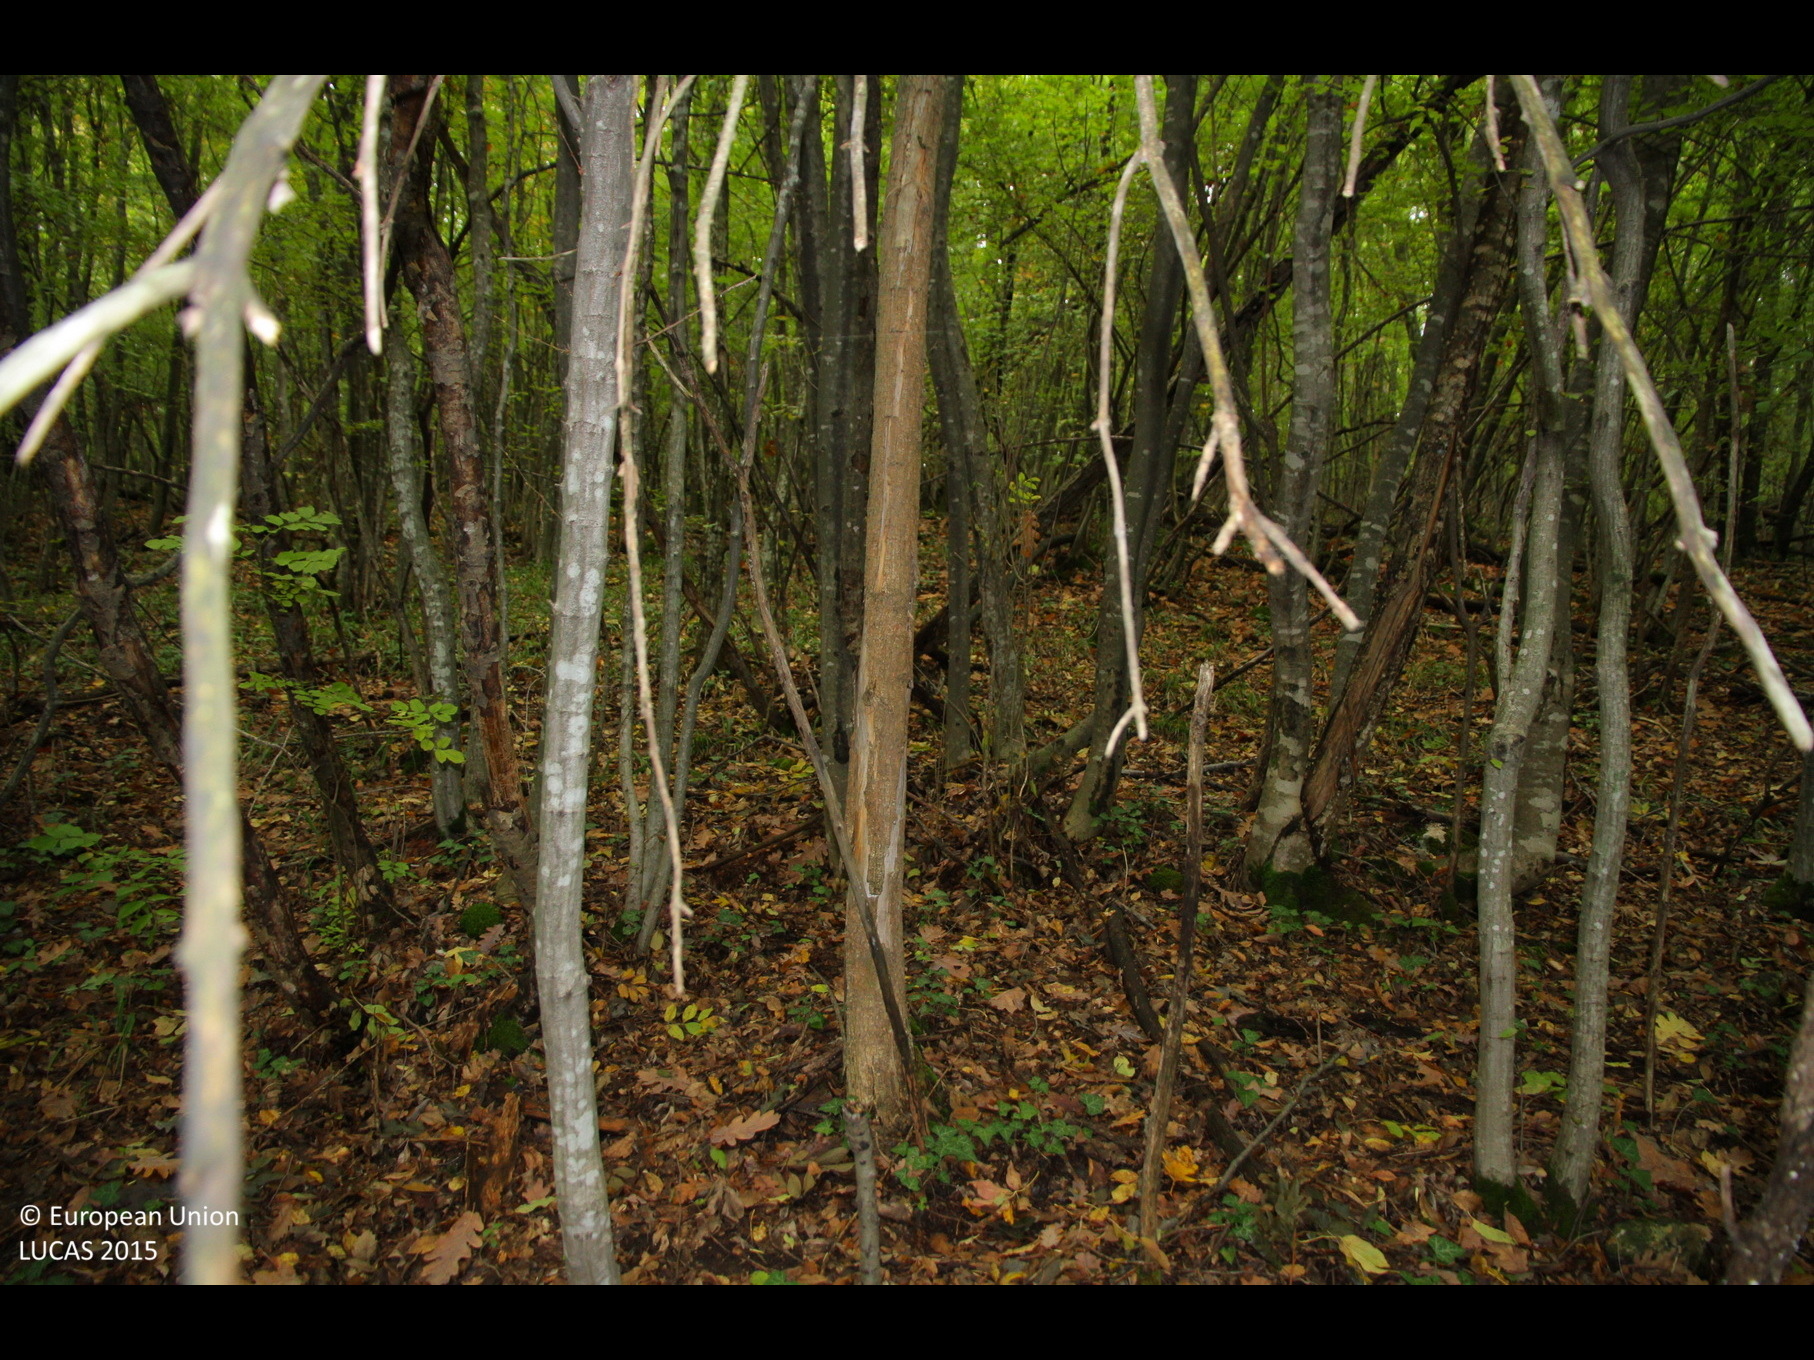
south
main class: Woodland
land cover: Broadleaved woodland
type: beech forest
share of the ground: > 75 %
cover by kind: broadleaved forest trees 100 %
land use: Forestry
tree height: > 5 m
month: October
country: BG
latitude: 43.4718
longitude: 27.0922
